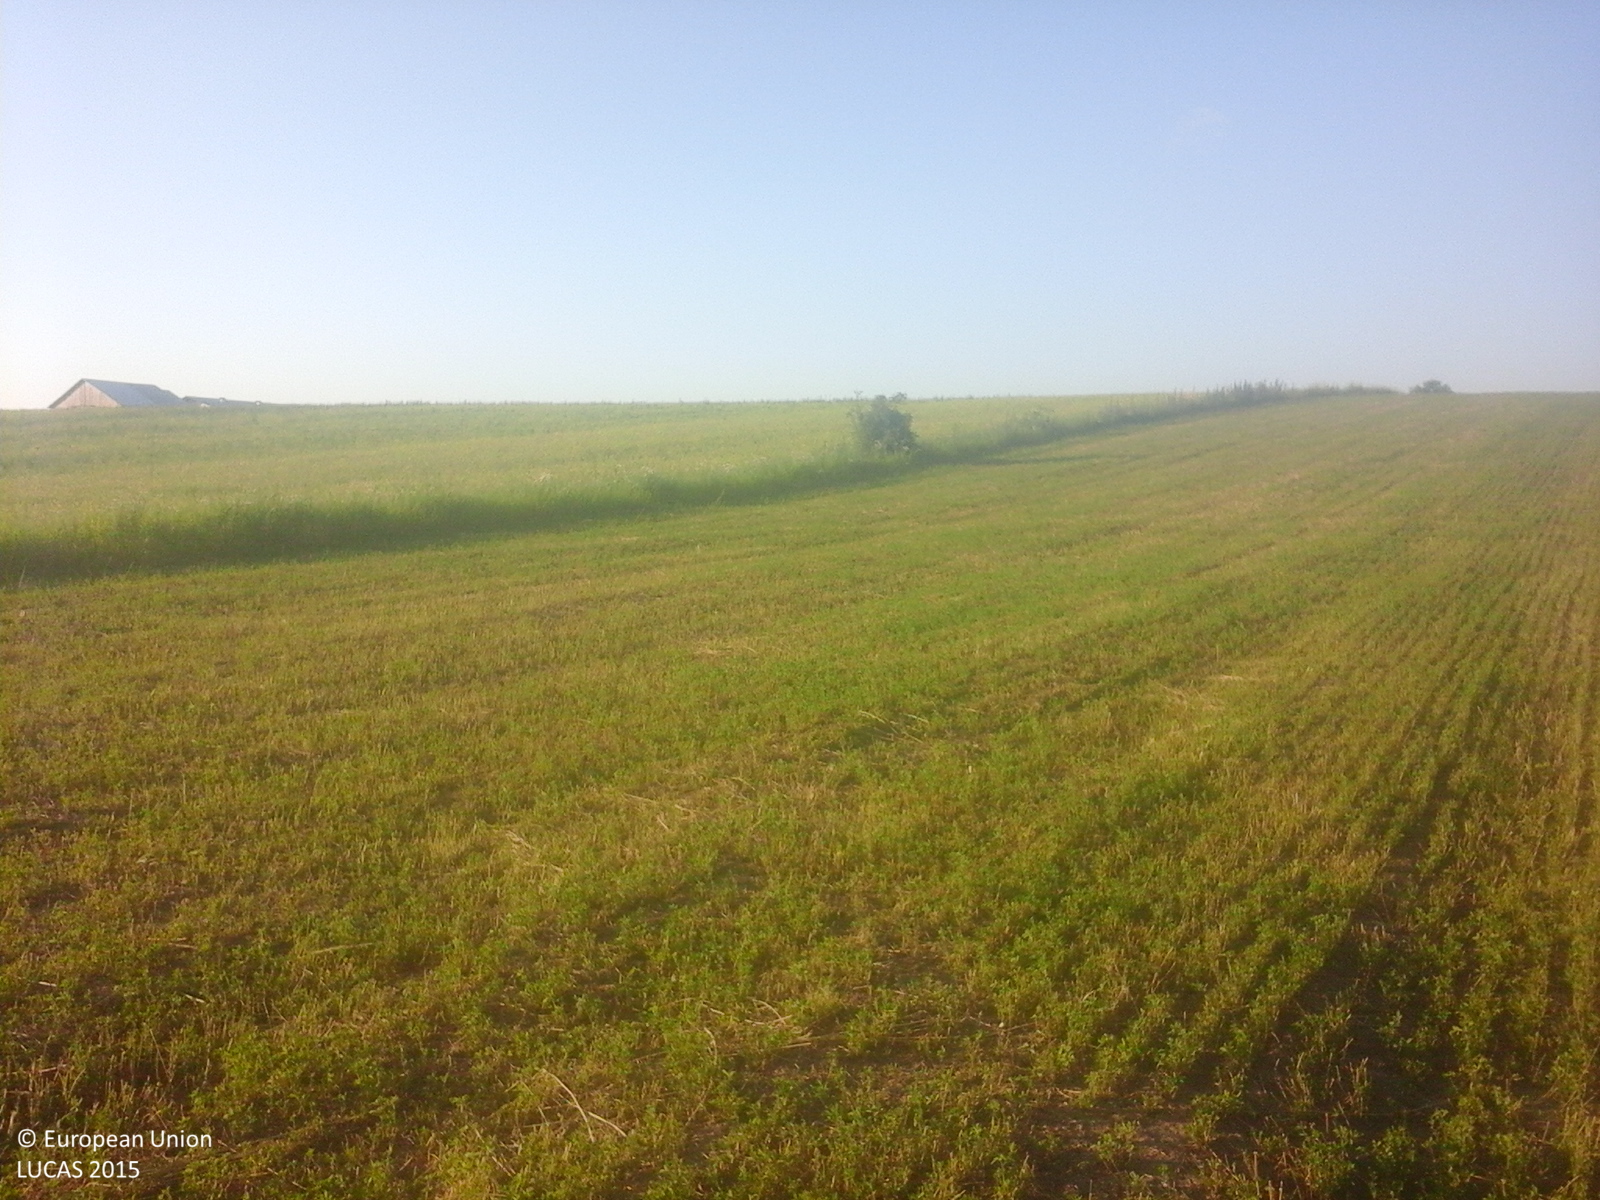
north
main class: Cropland
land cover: Lucerne
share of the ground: 25 - 50 %
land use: Agriculture (excluding fallow land and kitchen gardens)
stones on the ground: < 10 %
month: June
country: RO
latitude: 47.9578
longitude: 26.0285
